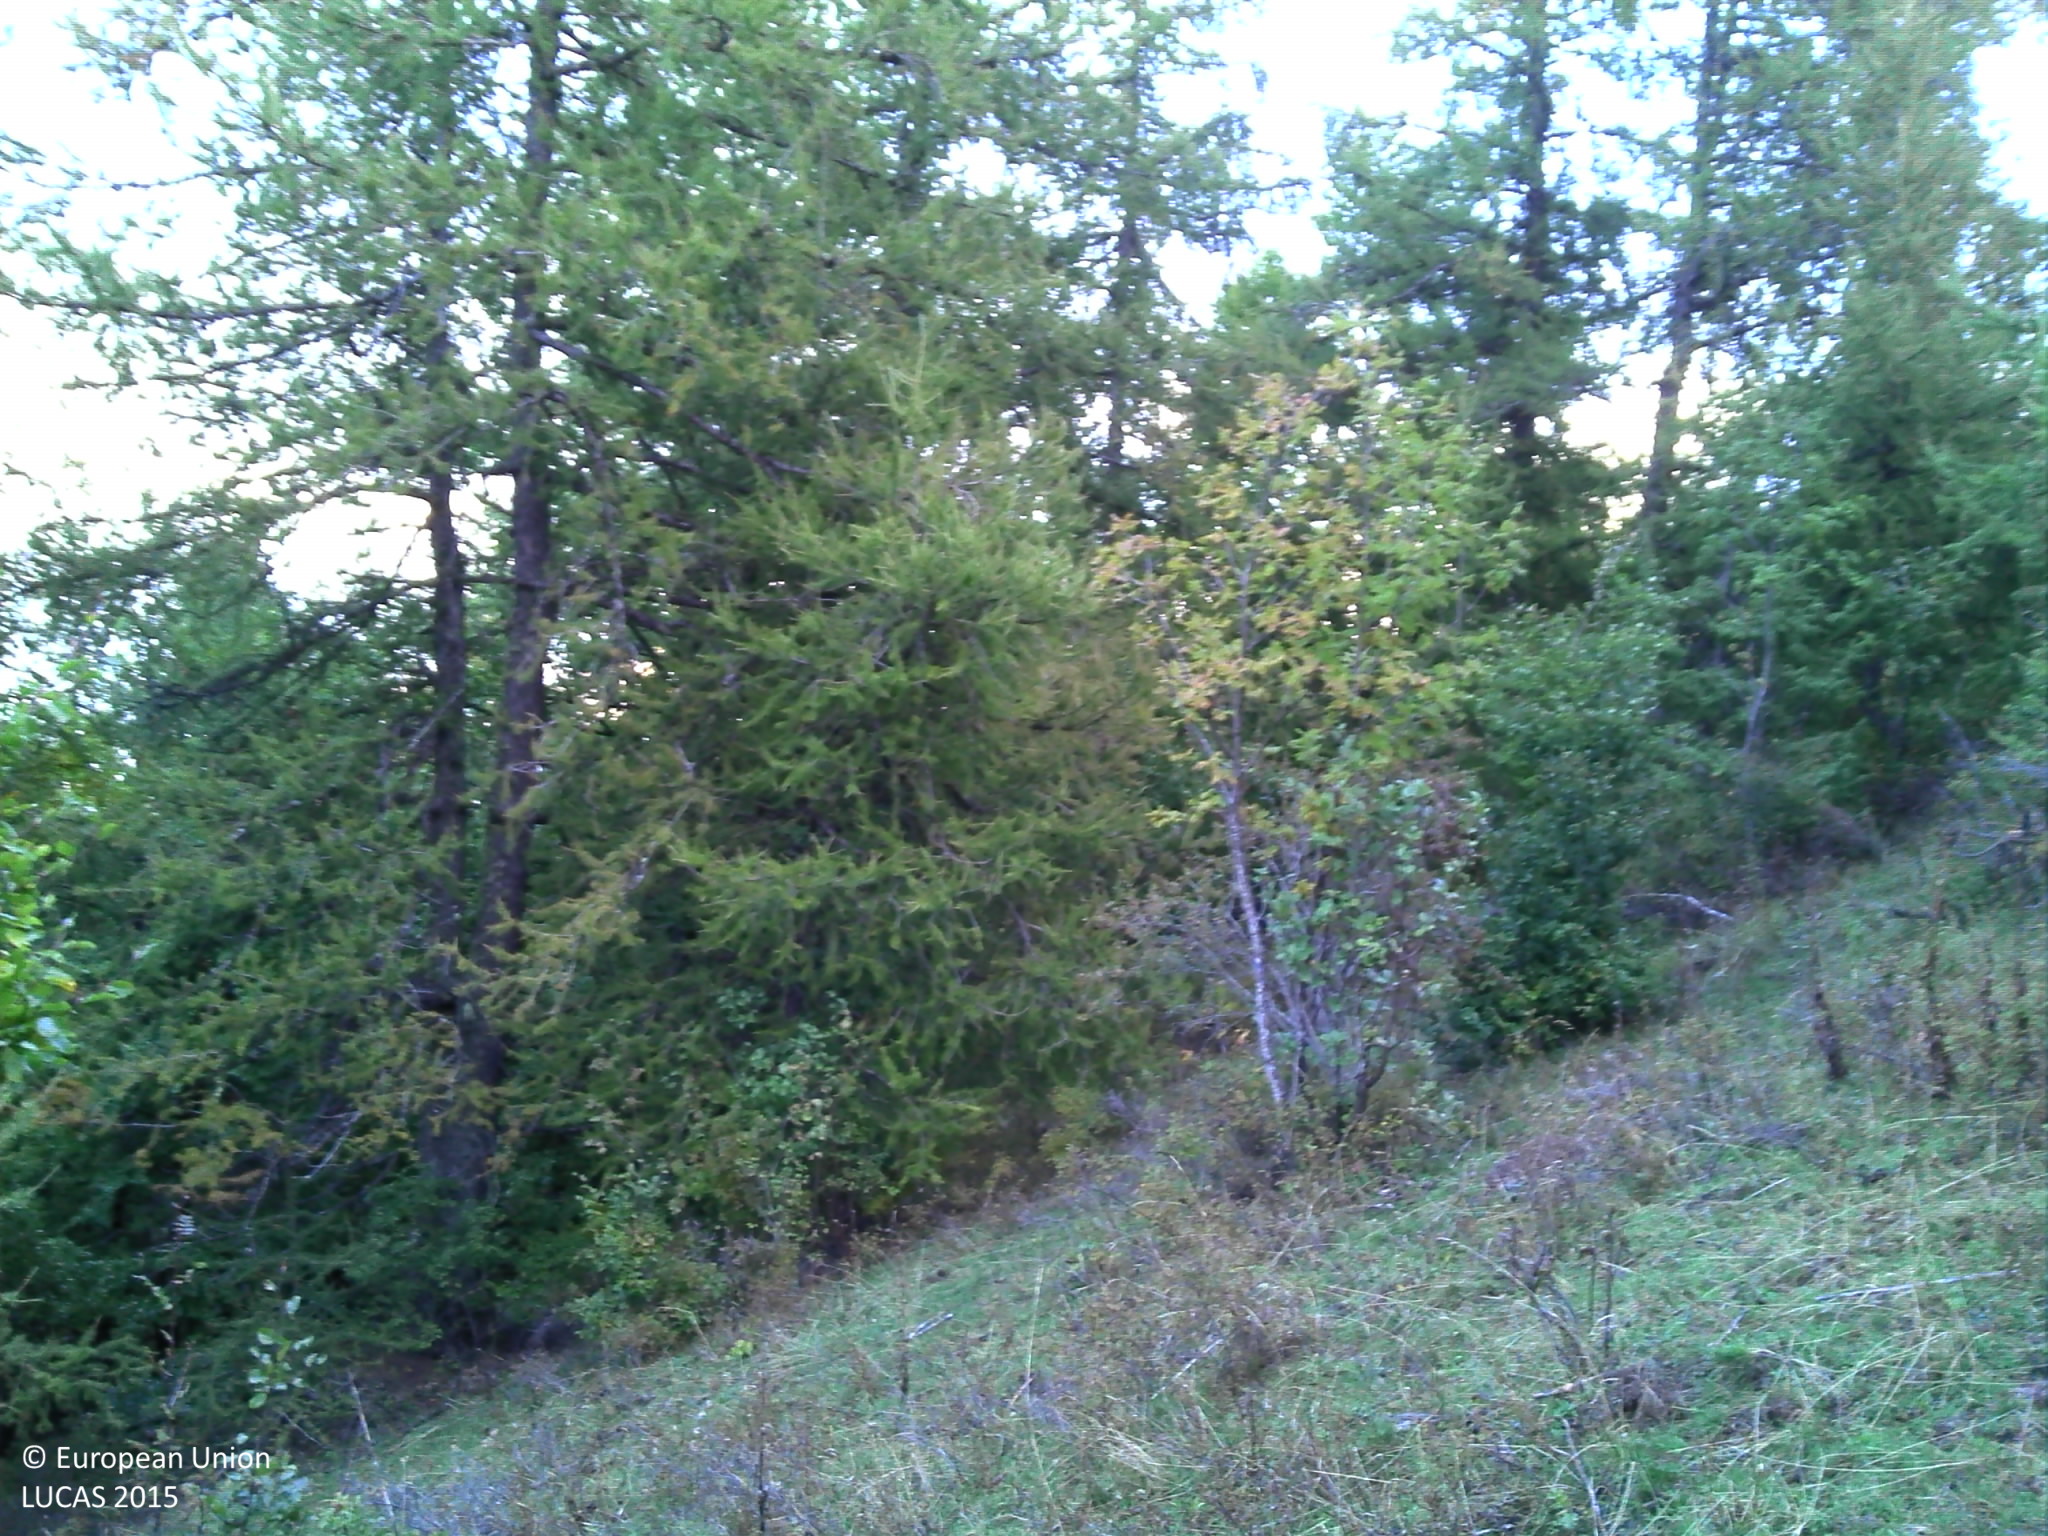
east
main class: Grassland
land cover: Grassland with sparse tree/shrub cover
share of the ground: > 75 %
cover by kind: herbaceous plants 85 %, shrubs 10 %, coniferous forest trees 5 %
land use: Agriculture (excluding fallow land and kitchen gardens)
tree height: > 5 m
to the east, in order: Grassland with sparse tree/shrub cover; Pine dominated mixed woodland; Broadleaved woodland; Fences; Broadleaved woodland; Pine dominated mixed woodland; Shrubland with sparse tree cover; Pine dominated mixed woodland
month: September
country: FR
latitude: 44.4984
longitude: 6.2211
